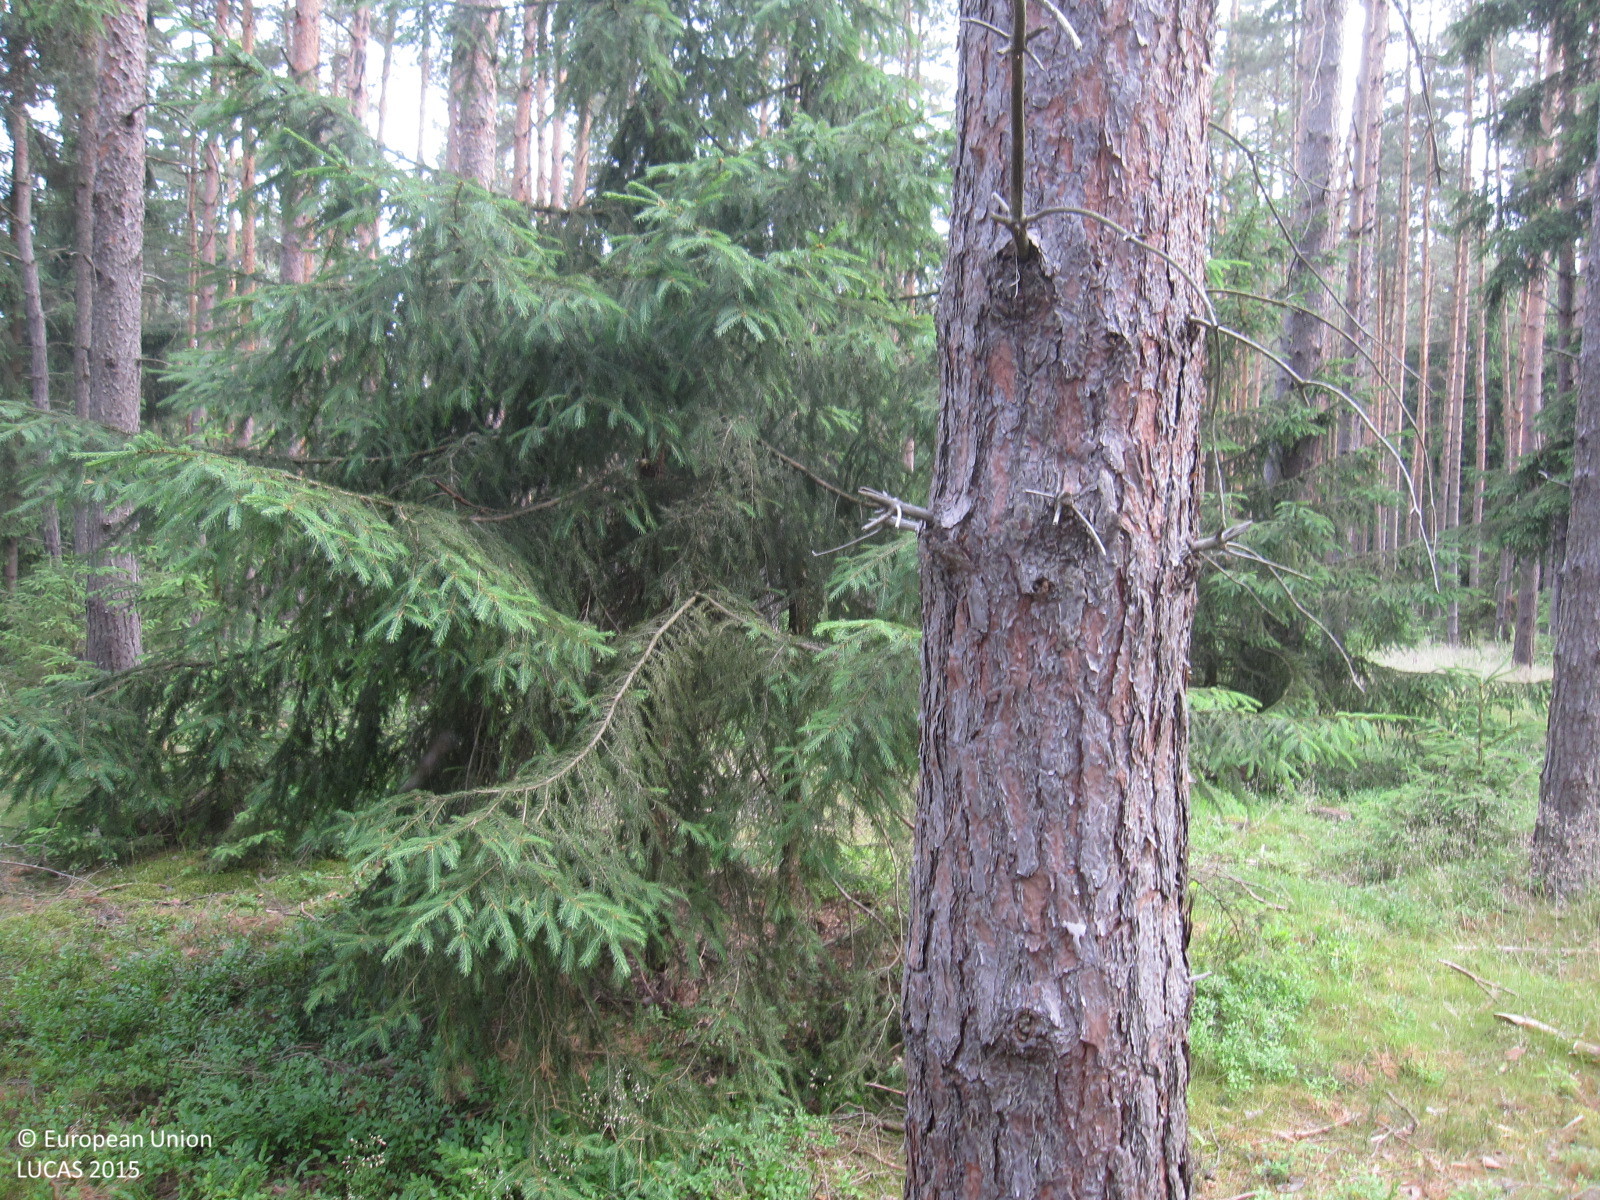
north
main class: Woodland
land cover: Pine dominated coniferous woodland
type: hemiboreal forest and nemoral coniferous forest and mixed broadleaved-coniferous forest
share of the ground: > 75 %
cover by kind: coniferous forest trees 75 %, lichens and mosses 15 %, shrubs 10 %
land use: Forestry
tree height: > 5 m
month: June
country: DE
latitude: 50.6245
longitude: 11.4556
